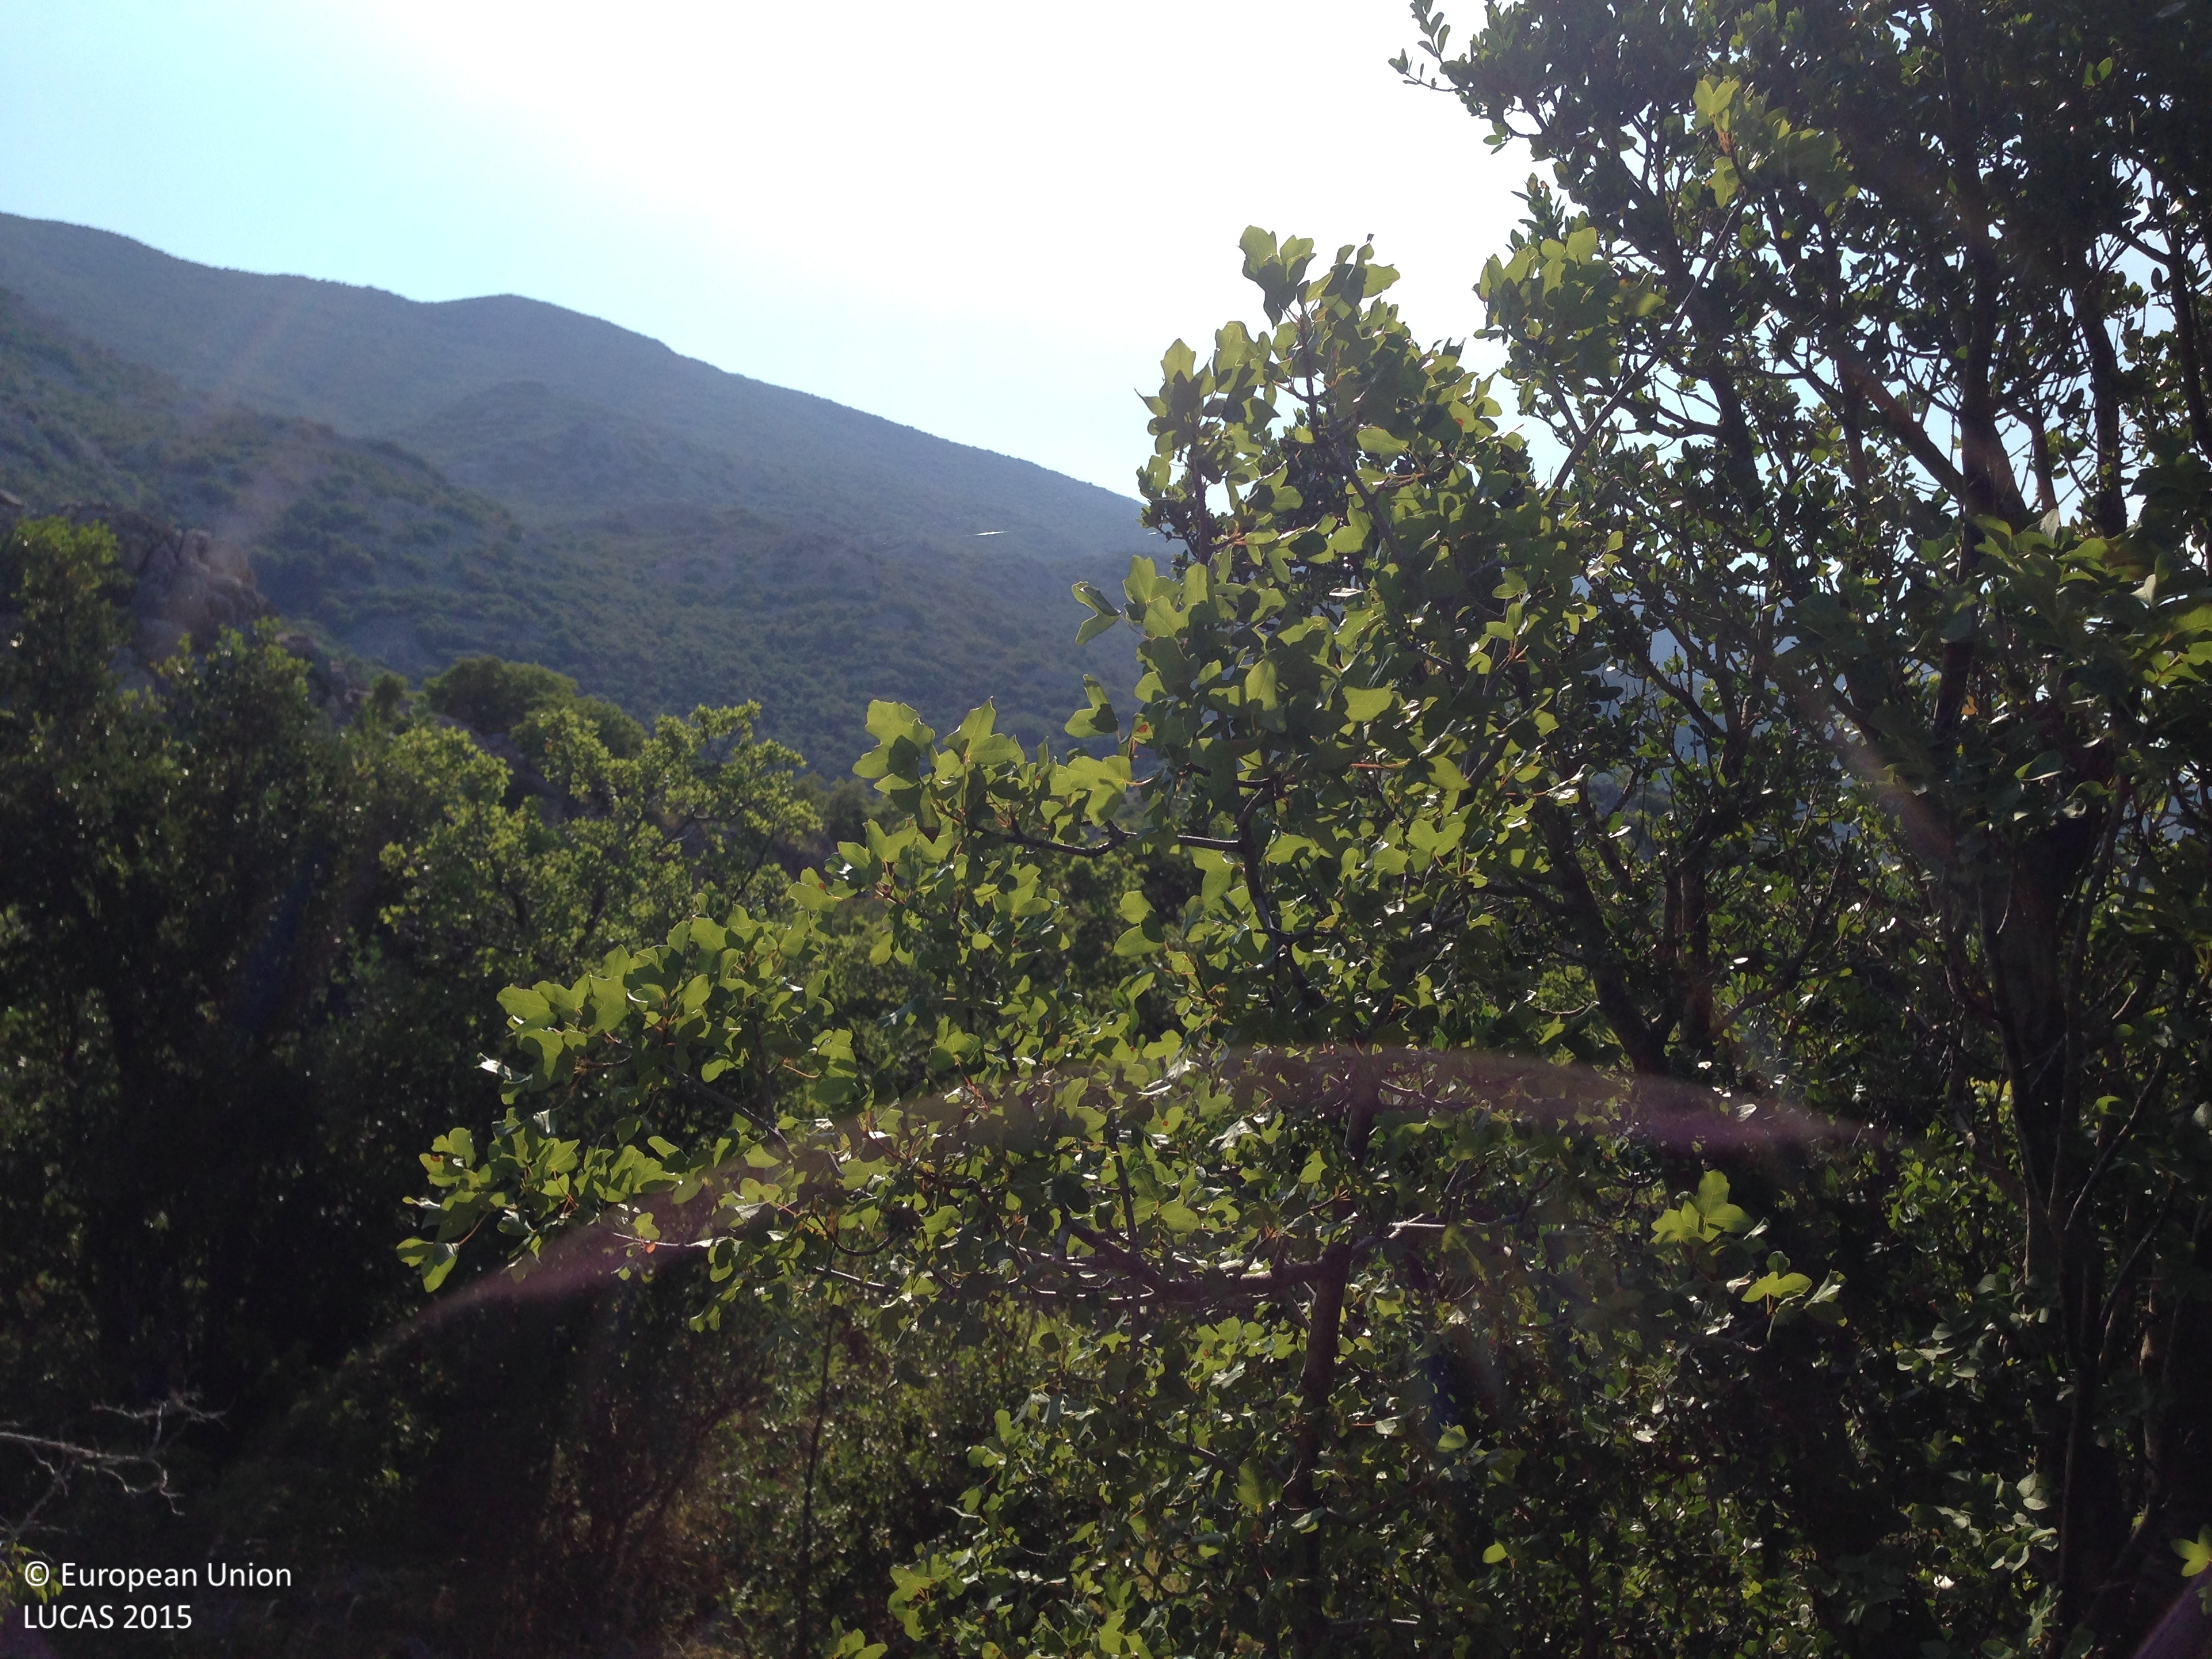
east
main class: Woodland
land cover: Other mixed woodland
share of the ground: 25 - 50 %
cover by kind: unconsolidated bare surface 30 %, herbaceous plants 20 %, broadleaved forest trees 15 %, shrubs 15 %, coniferous forest trees 10 %, consolidated bare surface 10 %
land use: Semi-natural and natural areas not in use
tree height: < 5 m
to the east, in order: Other mixed woodland; Tracks; Other mixed woodland; Paved roads, cycling and walking lanes; Other mixed woodland; Tracks; Other mixed woodland; Dry stone walls; Other mixed woodland; Dry stone walls; Other mixed woodland
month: July
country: HR
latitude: 44.5917
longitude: 14.9942
